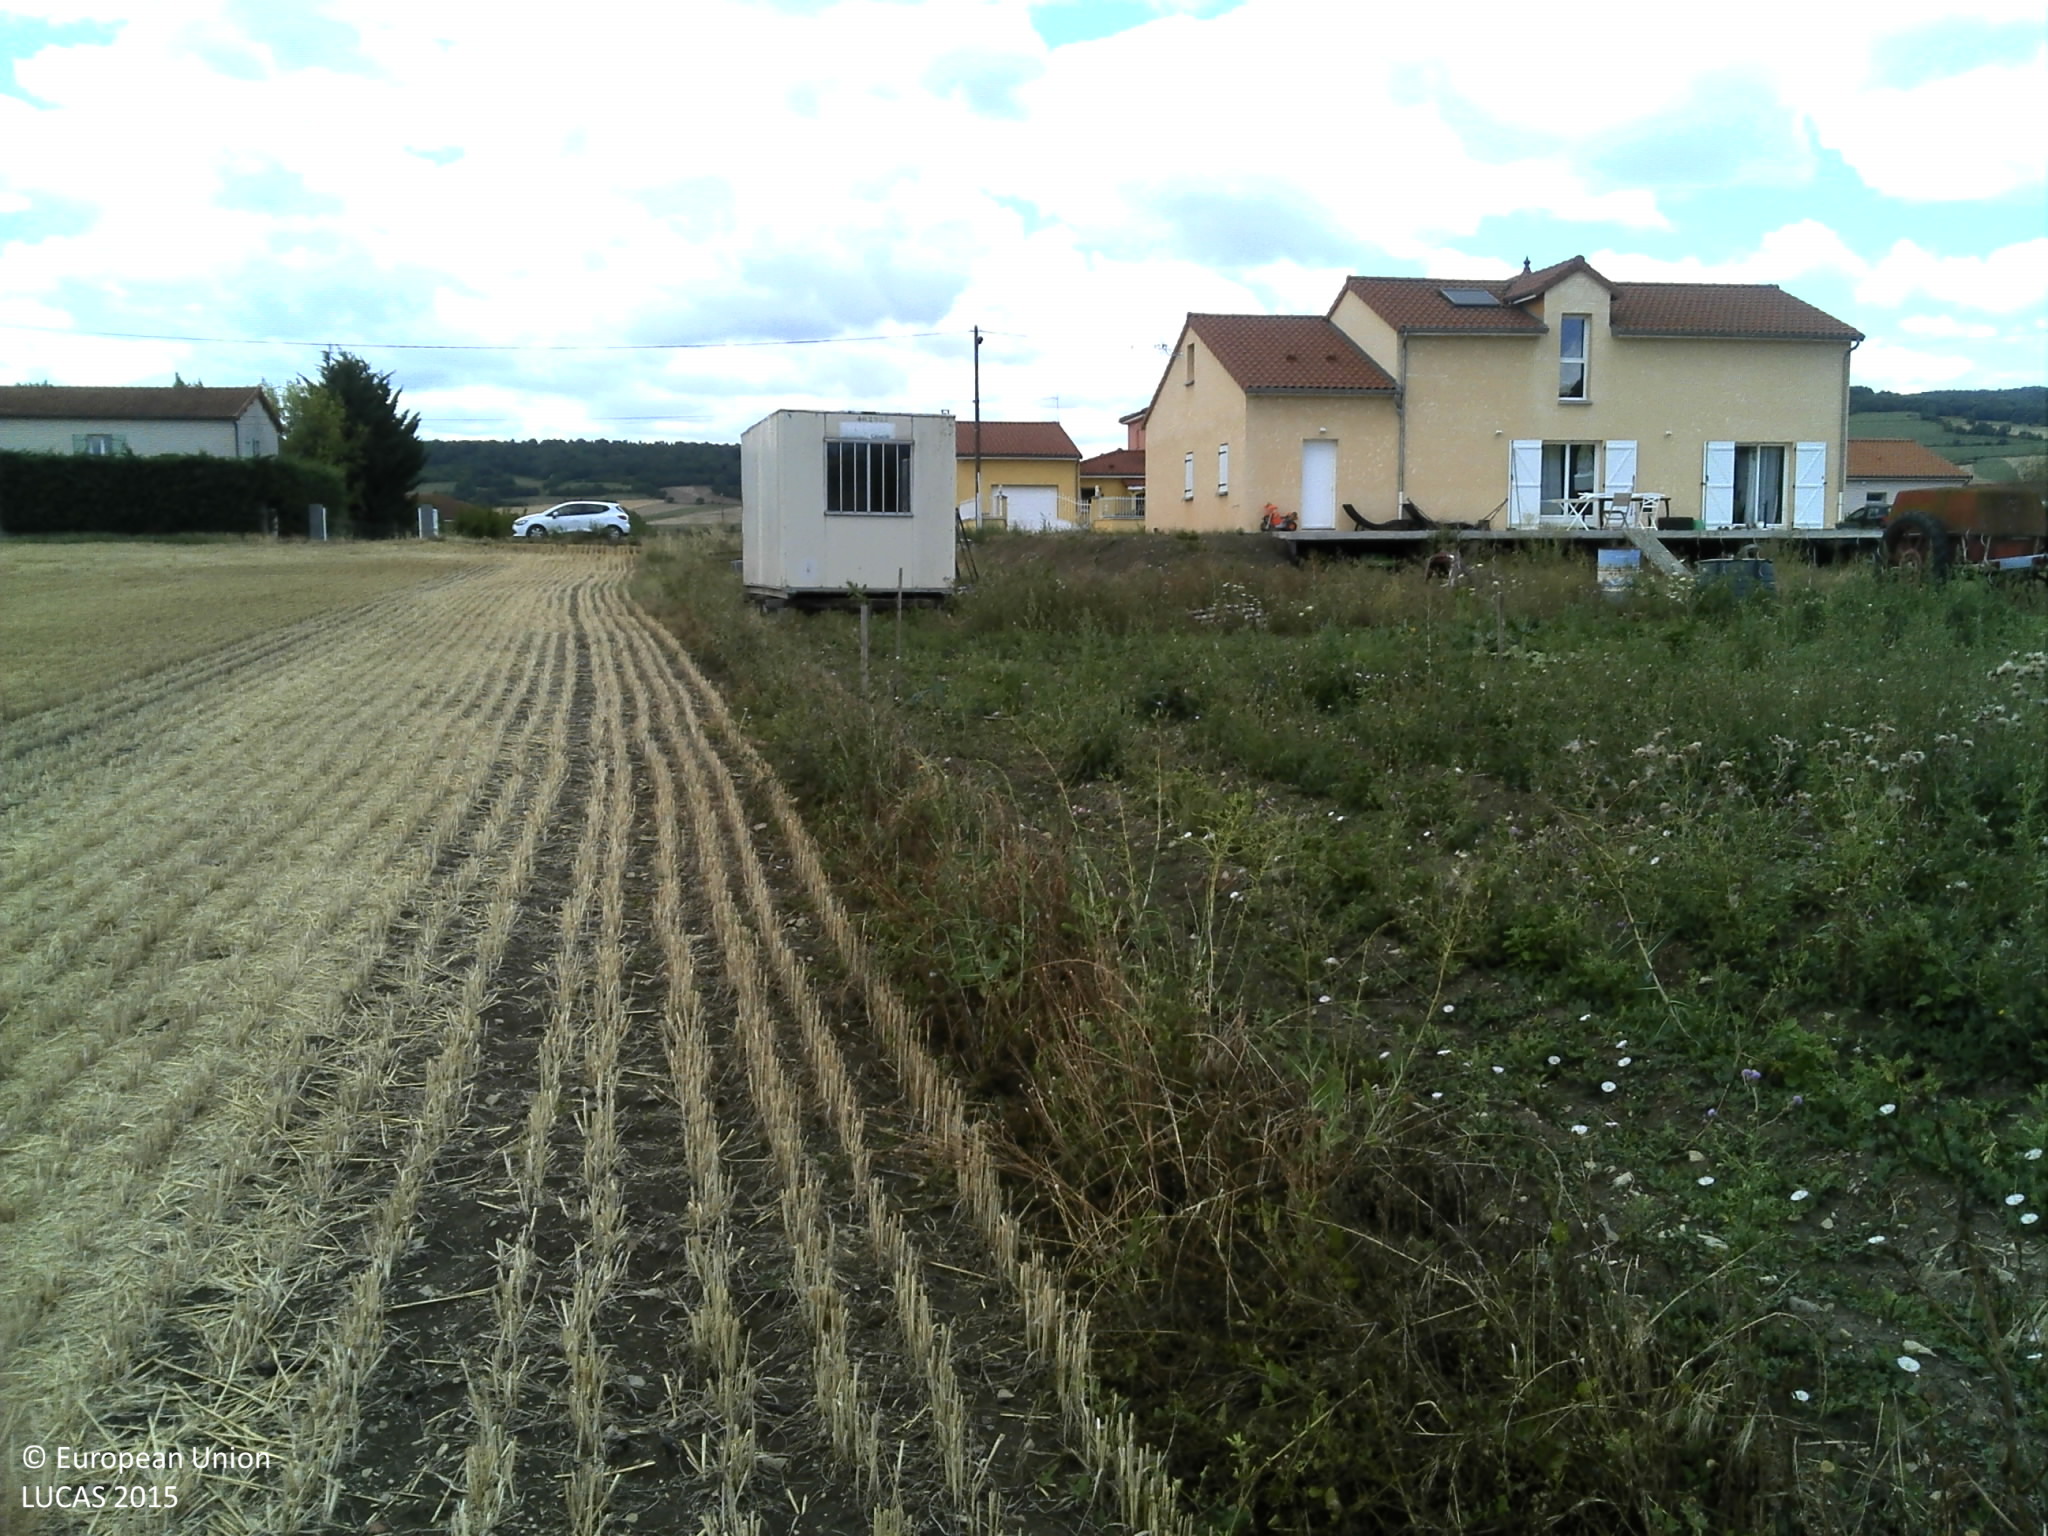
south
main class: Cropland
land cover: Potatoes
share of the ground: < 10 %
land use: Kitchen garden
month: July
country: FR
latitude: 45.5007
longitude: 3.1797
